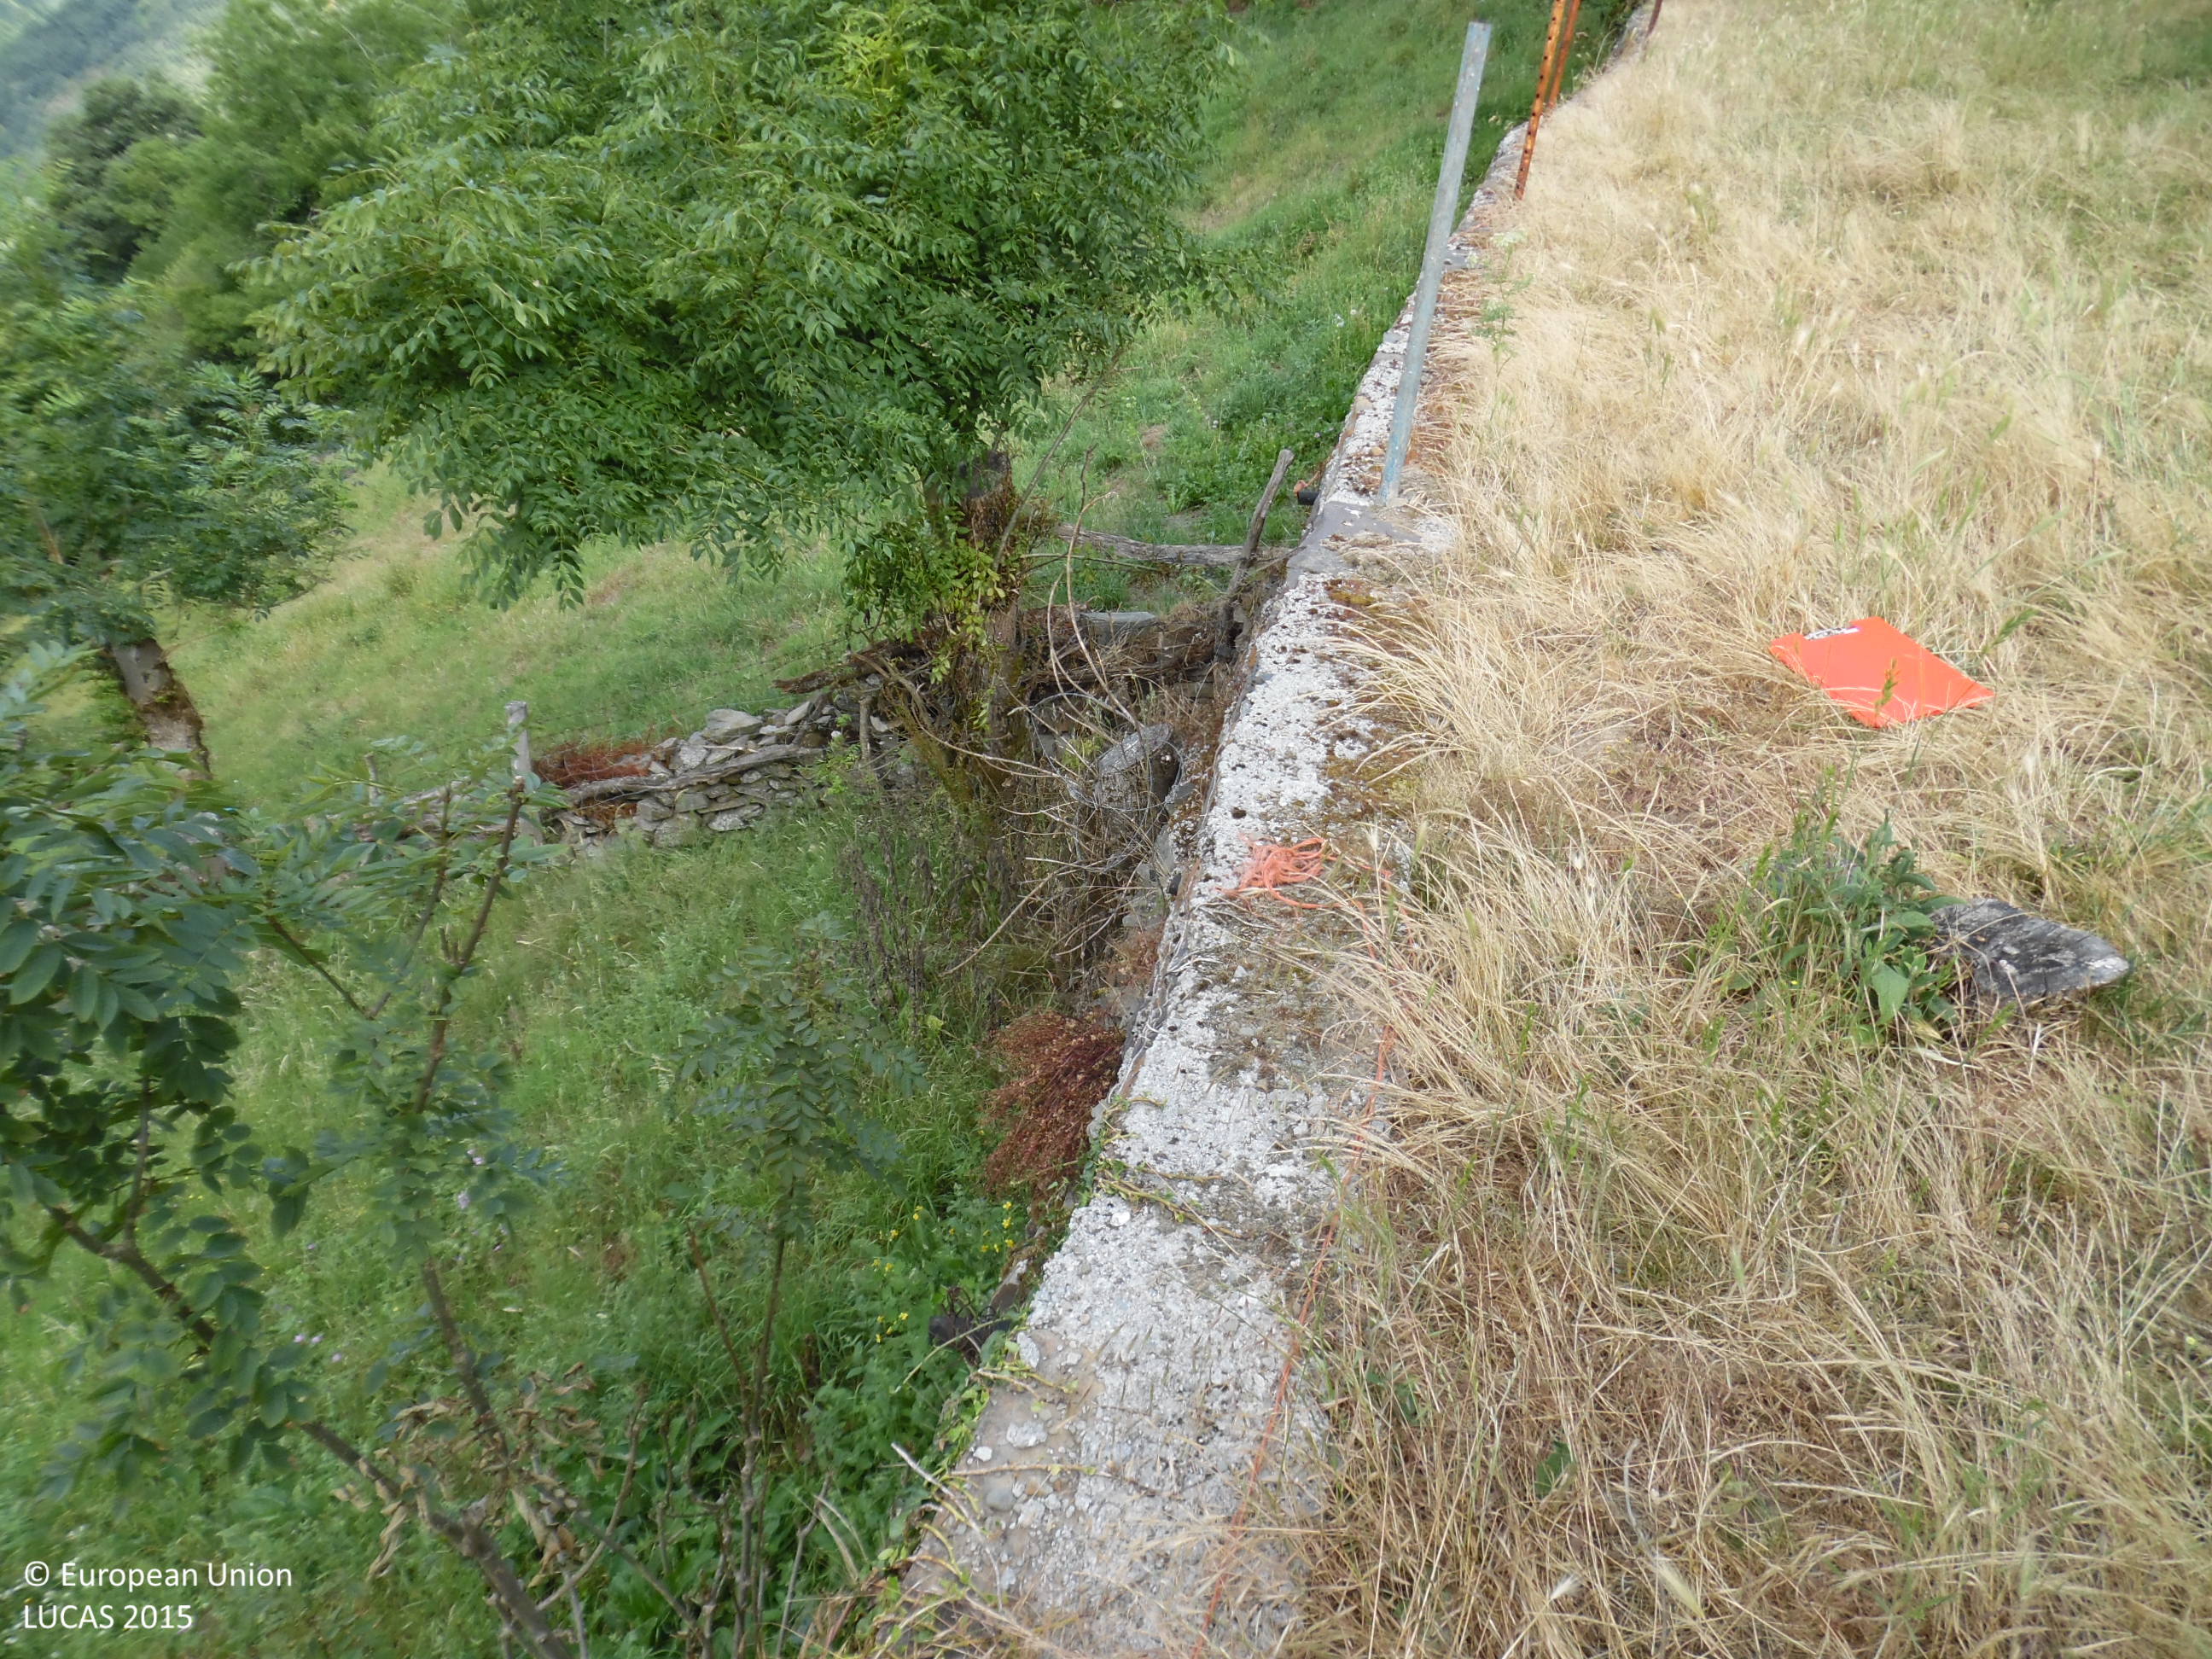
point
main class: Grassland
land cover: Grassland with sparse tree/shrub cover
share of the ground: > 75 %
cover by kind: herbaceous plants 90 %, broadleaved forest trees 5 %
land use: Agriculture (excluding fallow land and kitchen gardens)
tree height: > 5 m
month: July
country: ES
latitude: 43.0451
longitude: -6.5624
